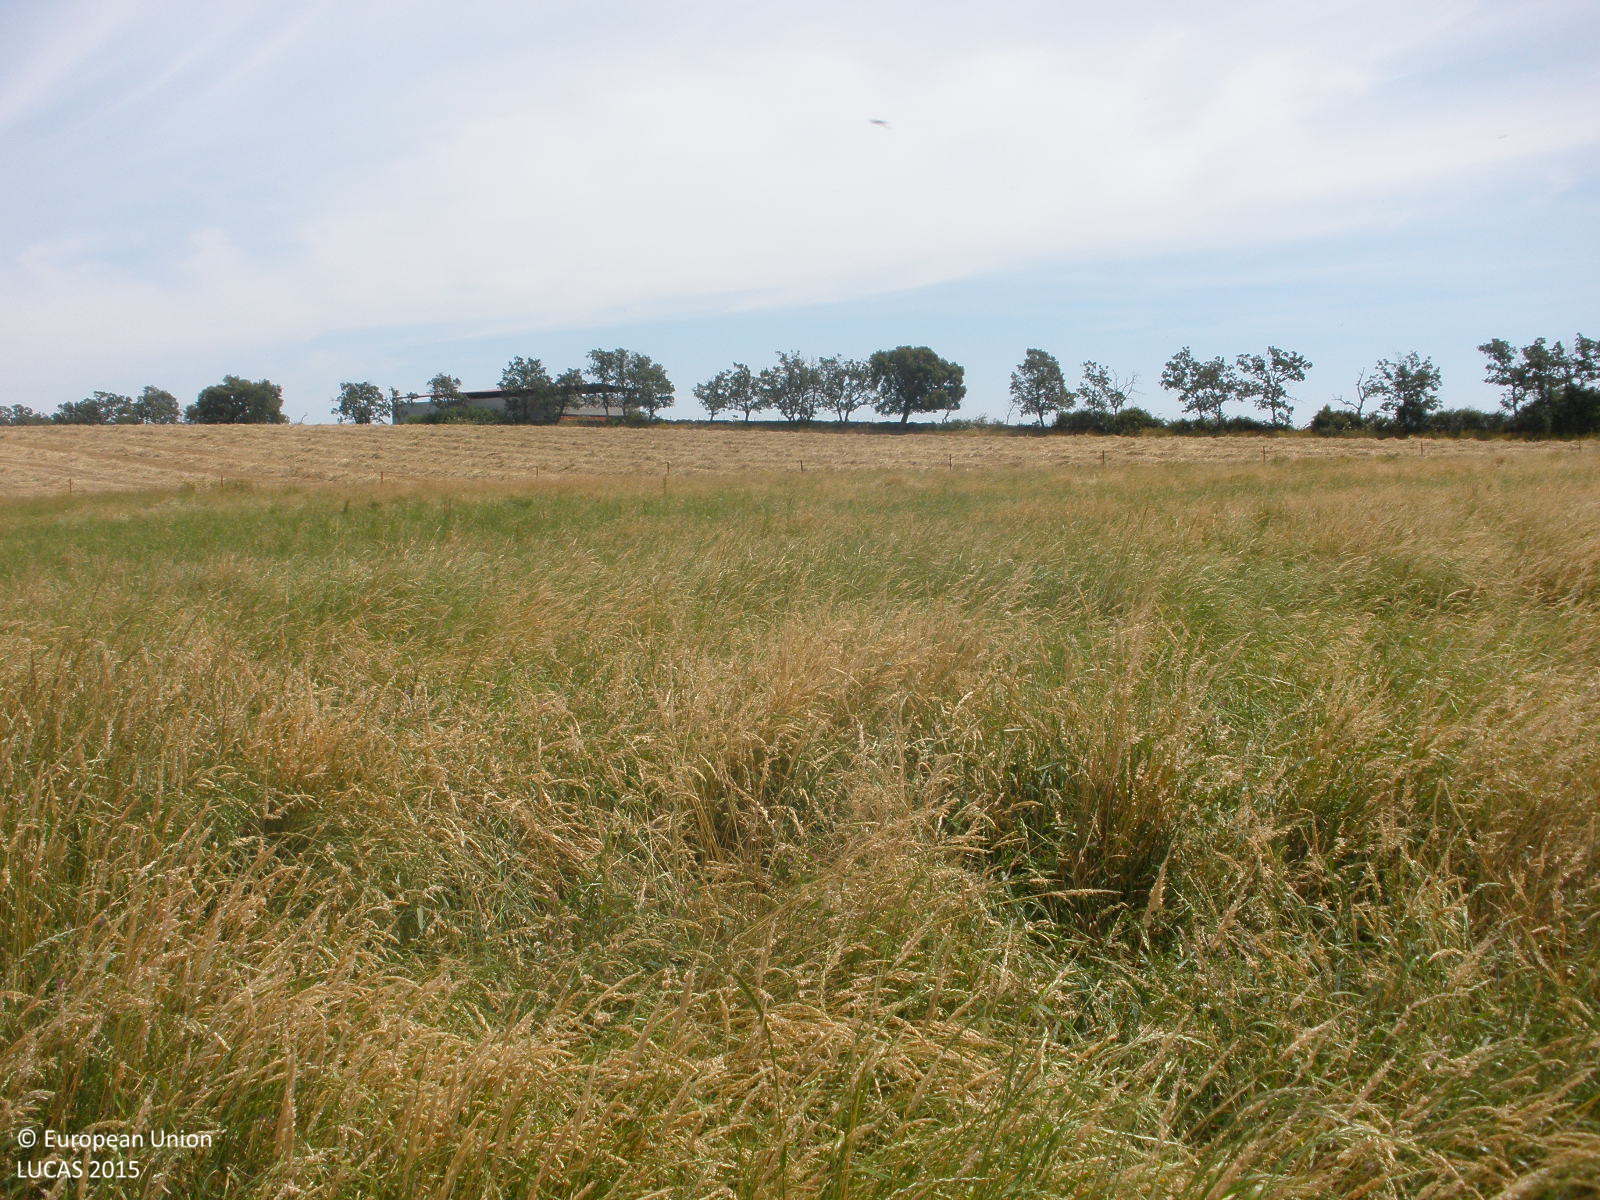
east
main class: Cropland
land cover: Mixed cereals for fodder
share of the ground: > 75 %
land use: Agriculture (excluding fallow land and kitchen gardens)
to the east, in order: Mixed cereals for fodder; Fences; Other leguminous and mixtures for fodder; Lines of trees; Dry stone walls; Fences; Grassland without tree/shrub cover; Tracks; Grassland without tree/shrub cover
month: May
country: ES
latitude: 40.1049
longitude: -6.5410
